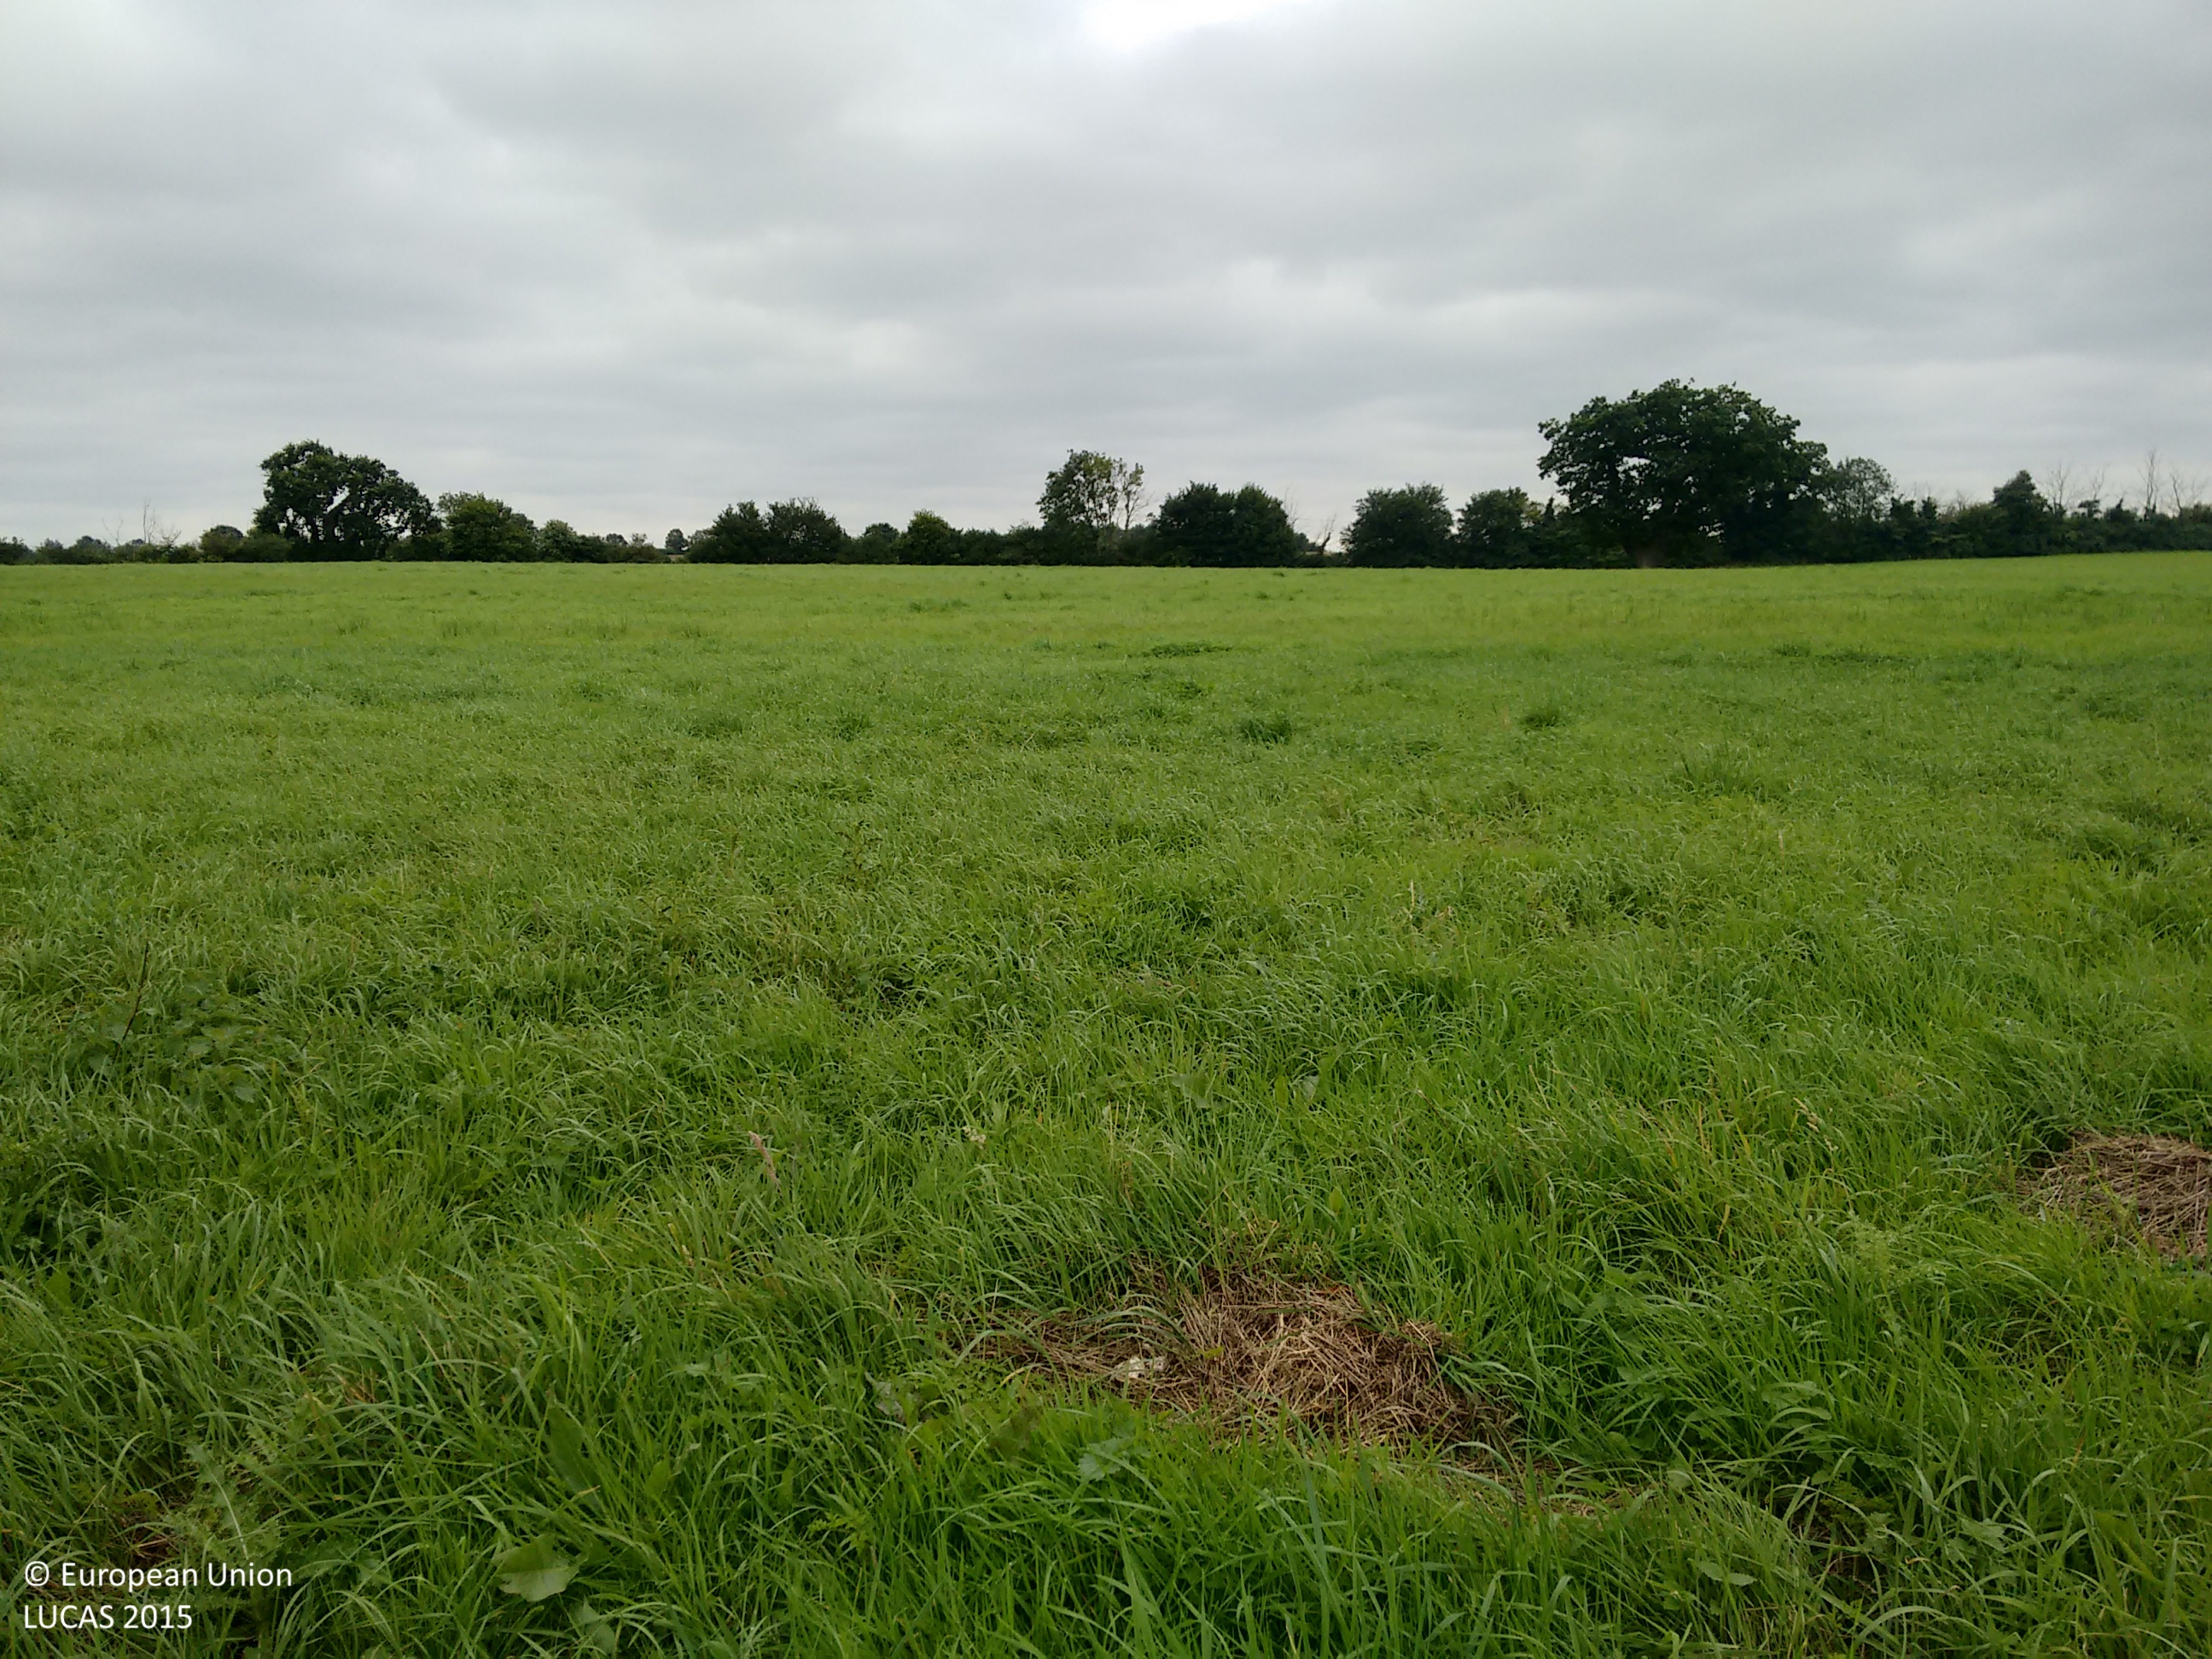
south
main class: Grassland
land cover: Grassland without tree/shrub cover
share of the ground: > 75 %
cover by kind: herbaceous plants 100 %
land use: Agriculture (excluding fallow land and kitchen gardens)
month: September
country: GB
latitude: 52.2809
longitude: 0.9028
